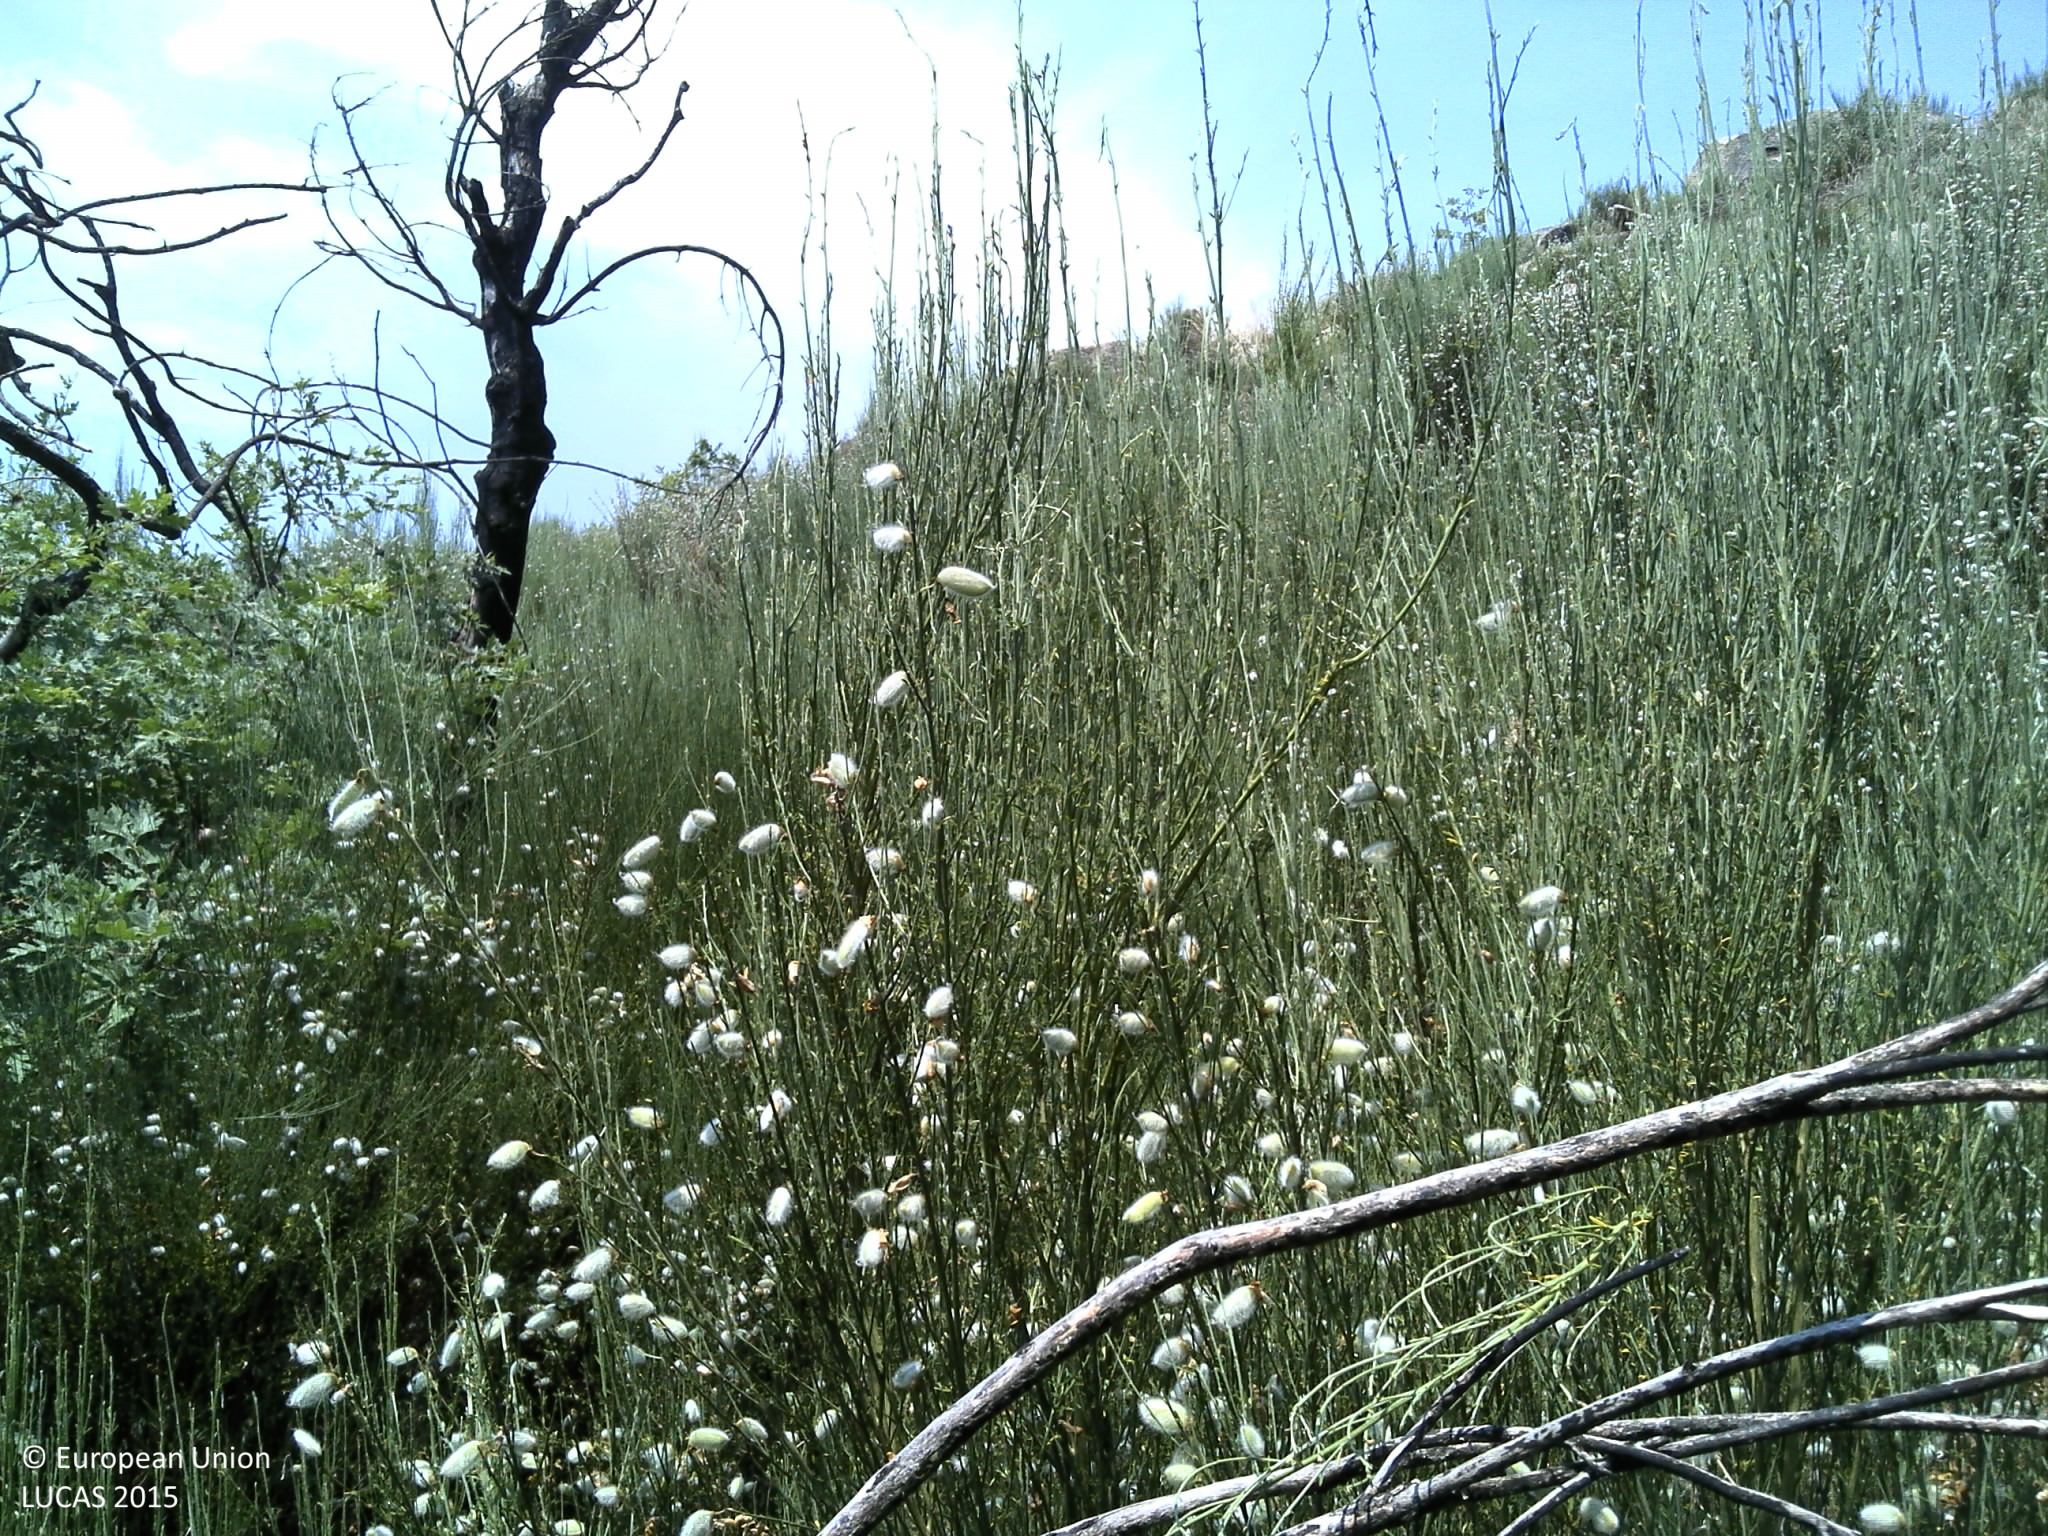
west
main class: Shrubland
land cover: Shrubland with sparse tree cover
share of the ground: > 75 %
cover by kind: shrubs 80 %, herbaceous plants 10 %, broadleaved forest trees 5 %, consolidated bare surface 5 %
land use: Semi-natural and natural areas not in use
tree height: > 5 m
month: June
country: PT
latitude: 41.4325
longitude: -7.5884
